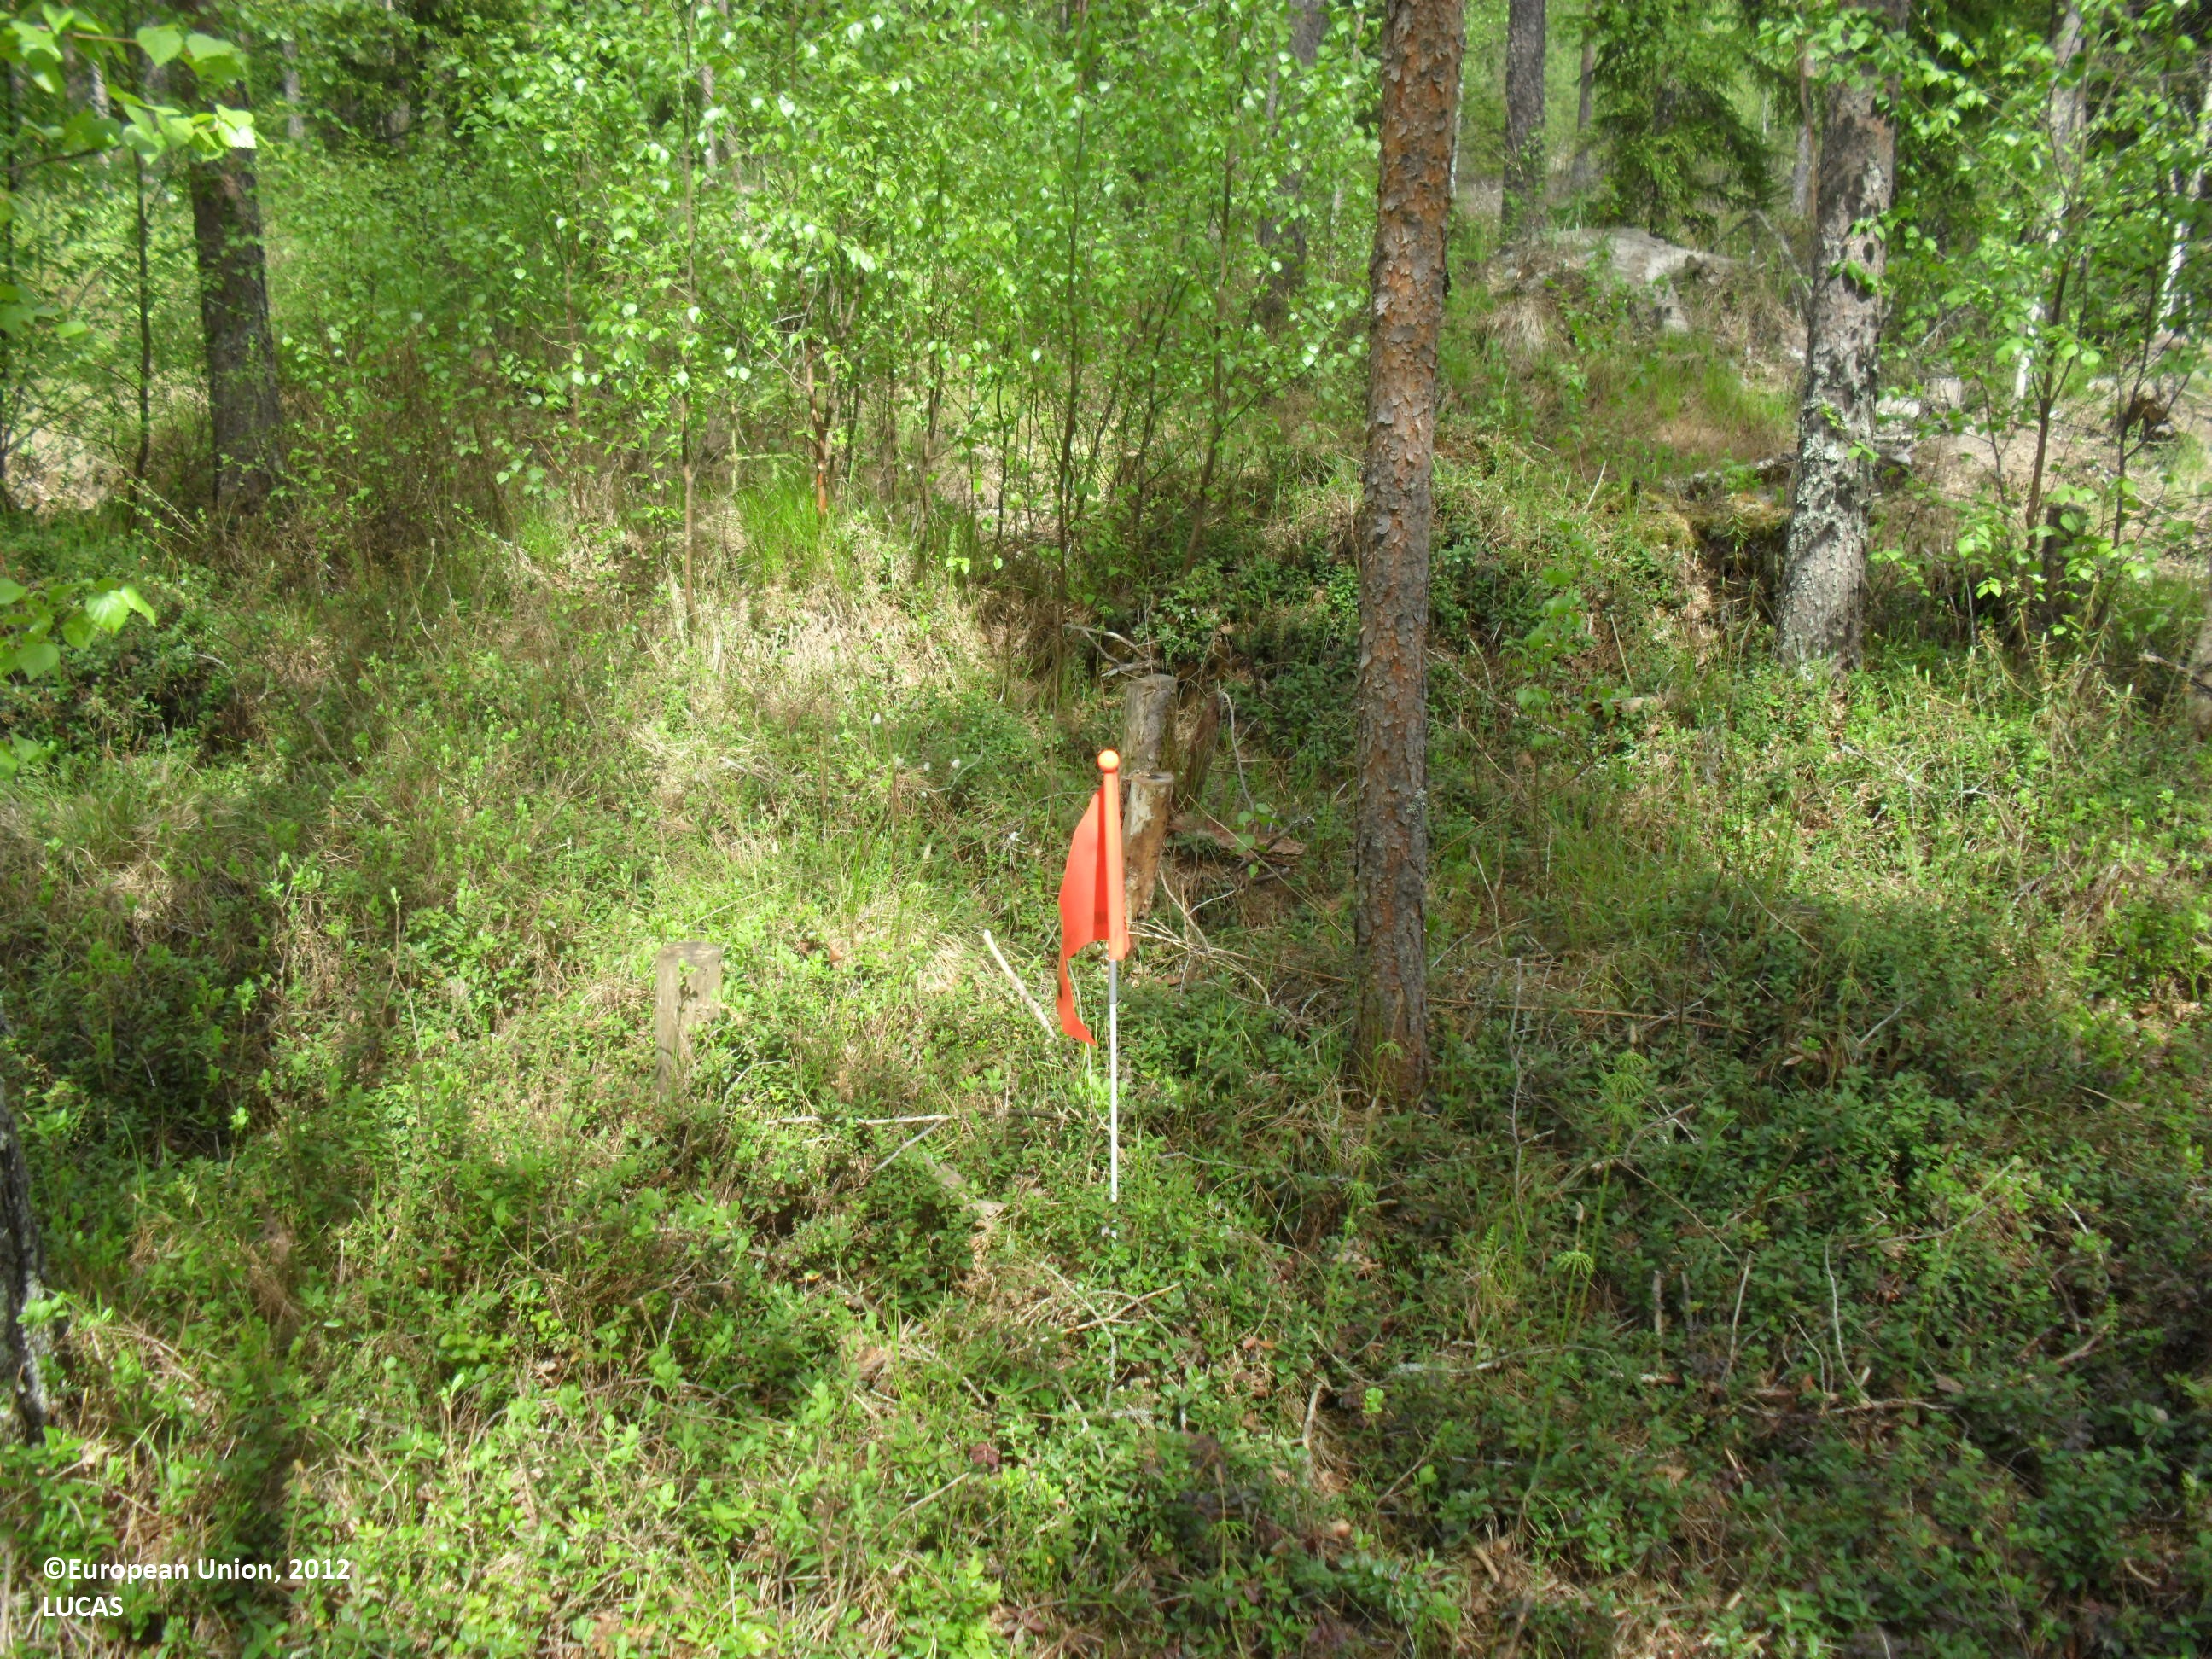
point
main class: Woodland
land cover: Pine dominated coniferous woodland
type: boreal forest
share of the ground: 50 - 75 %
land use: Forestry
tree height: > 5 m
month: June
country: FI
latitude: 63.1417
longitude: 23.2549
